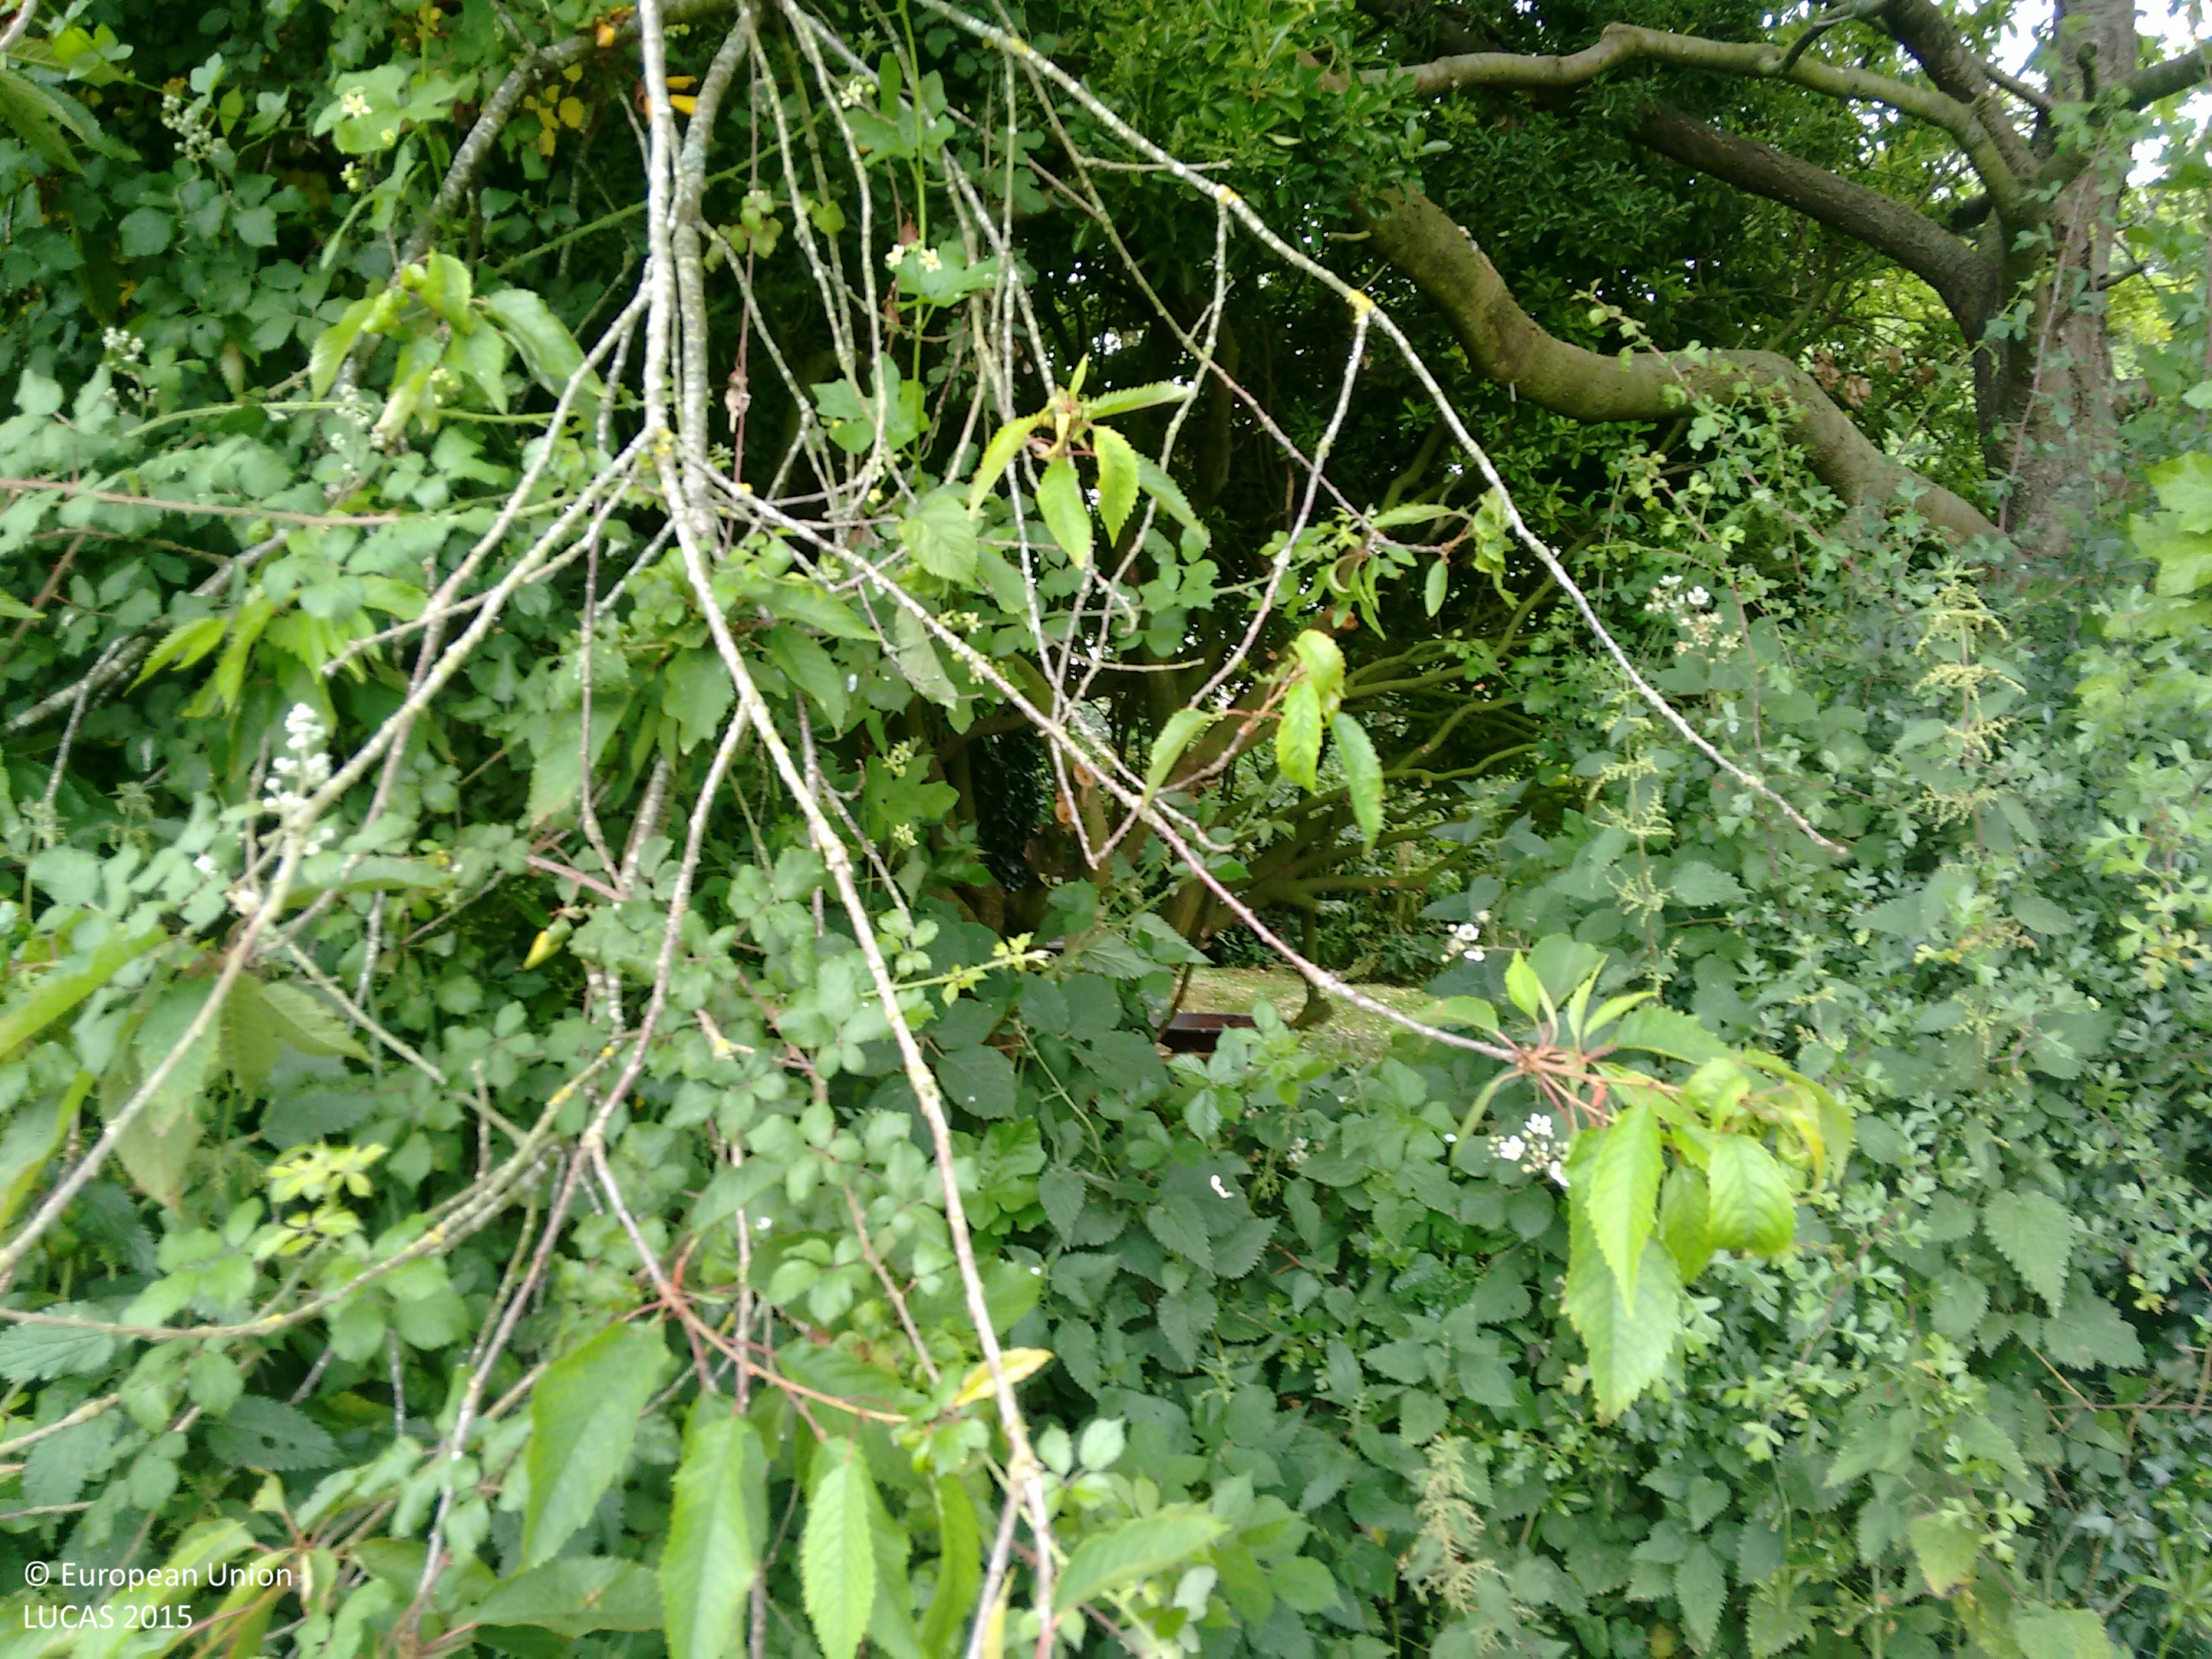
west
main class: Cropland
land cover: Barley
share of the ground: > 75 %
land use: Agriculture (excluding fallow land and kitchen gardens)
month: July
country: GB
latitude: 50.8700
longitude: -0.7699
